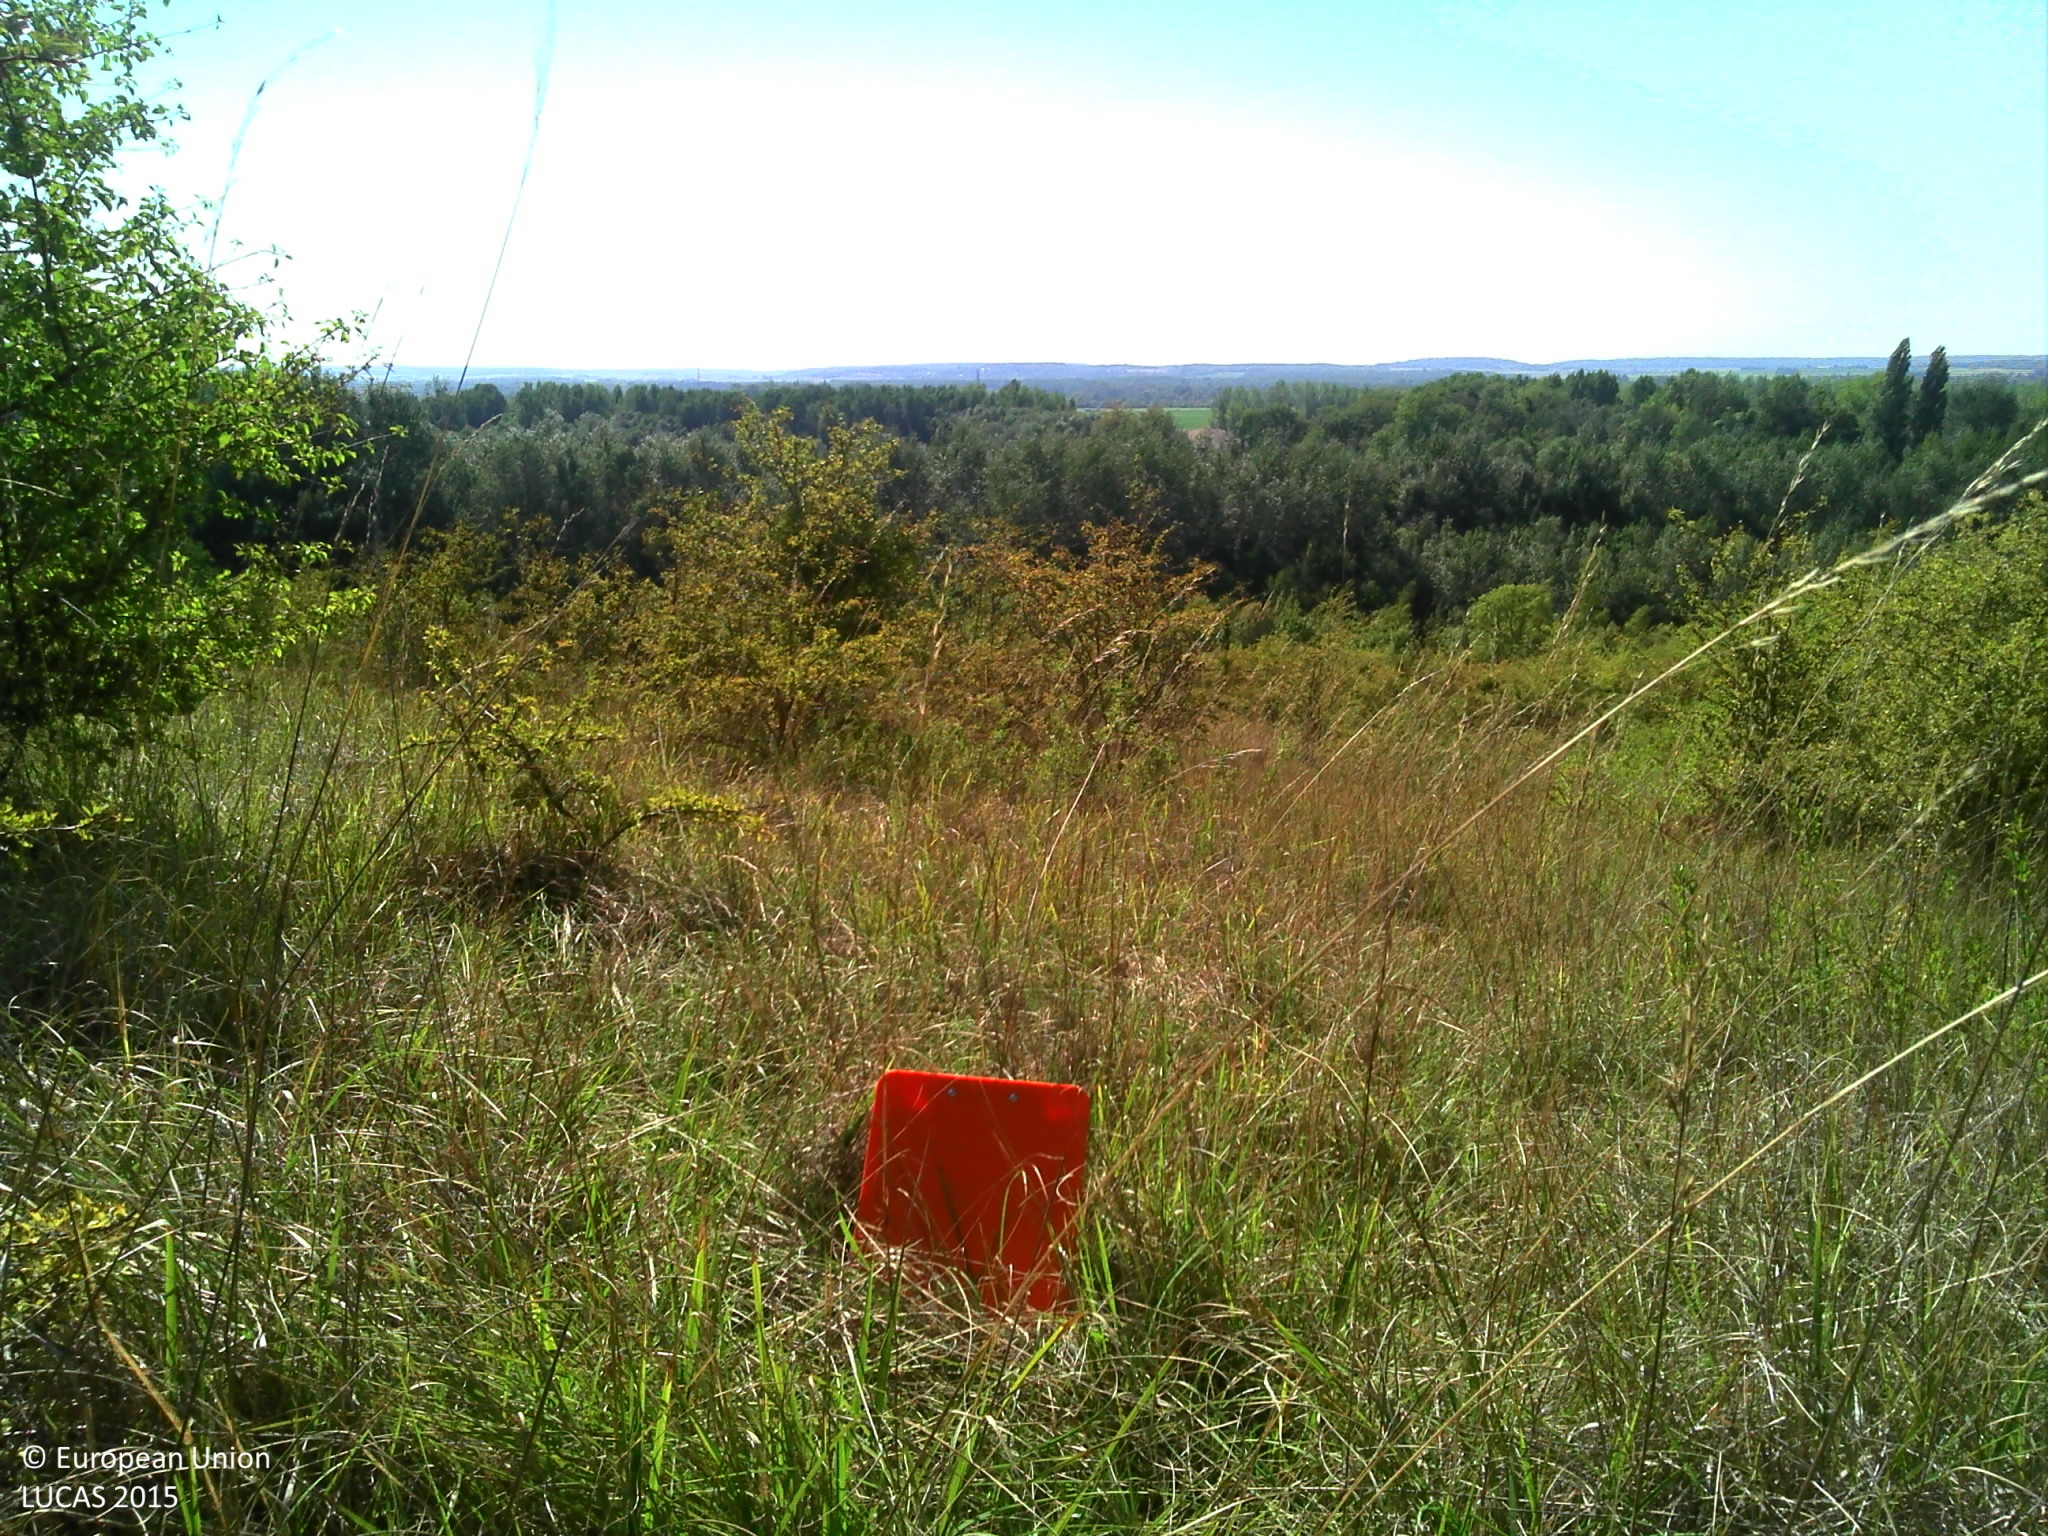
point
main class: Shrubland
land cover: Shrubland with sparse tree cover
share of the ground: > 75 %
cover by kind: herbaceous plants 85 %, shrubs 10 %, broadleaved forest trees 5 %
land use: Semi-natural and natural areas not in use
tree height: < 5 m
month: September
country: FR
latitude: 48.3988
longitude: 3.0090
